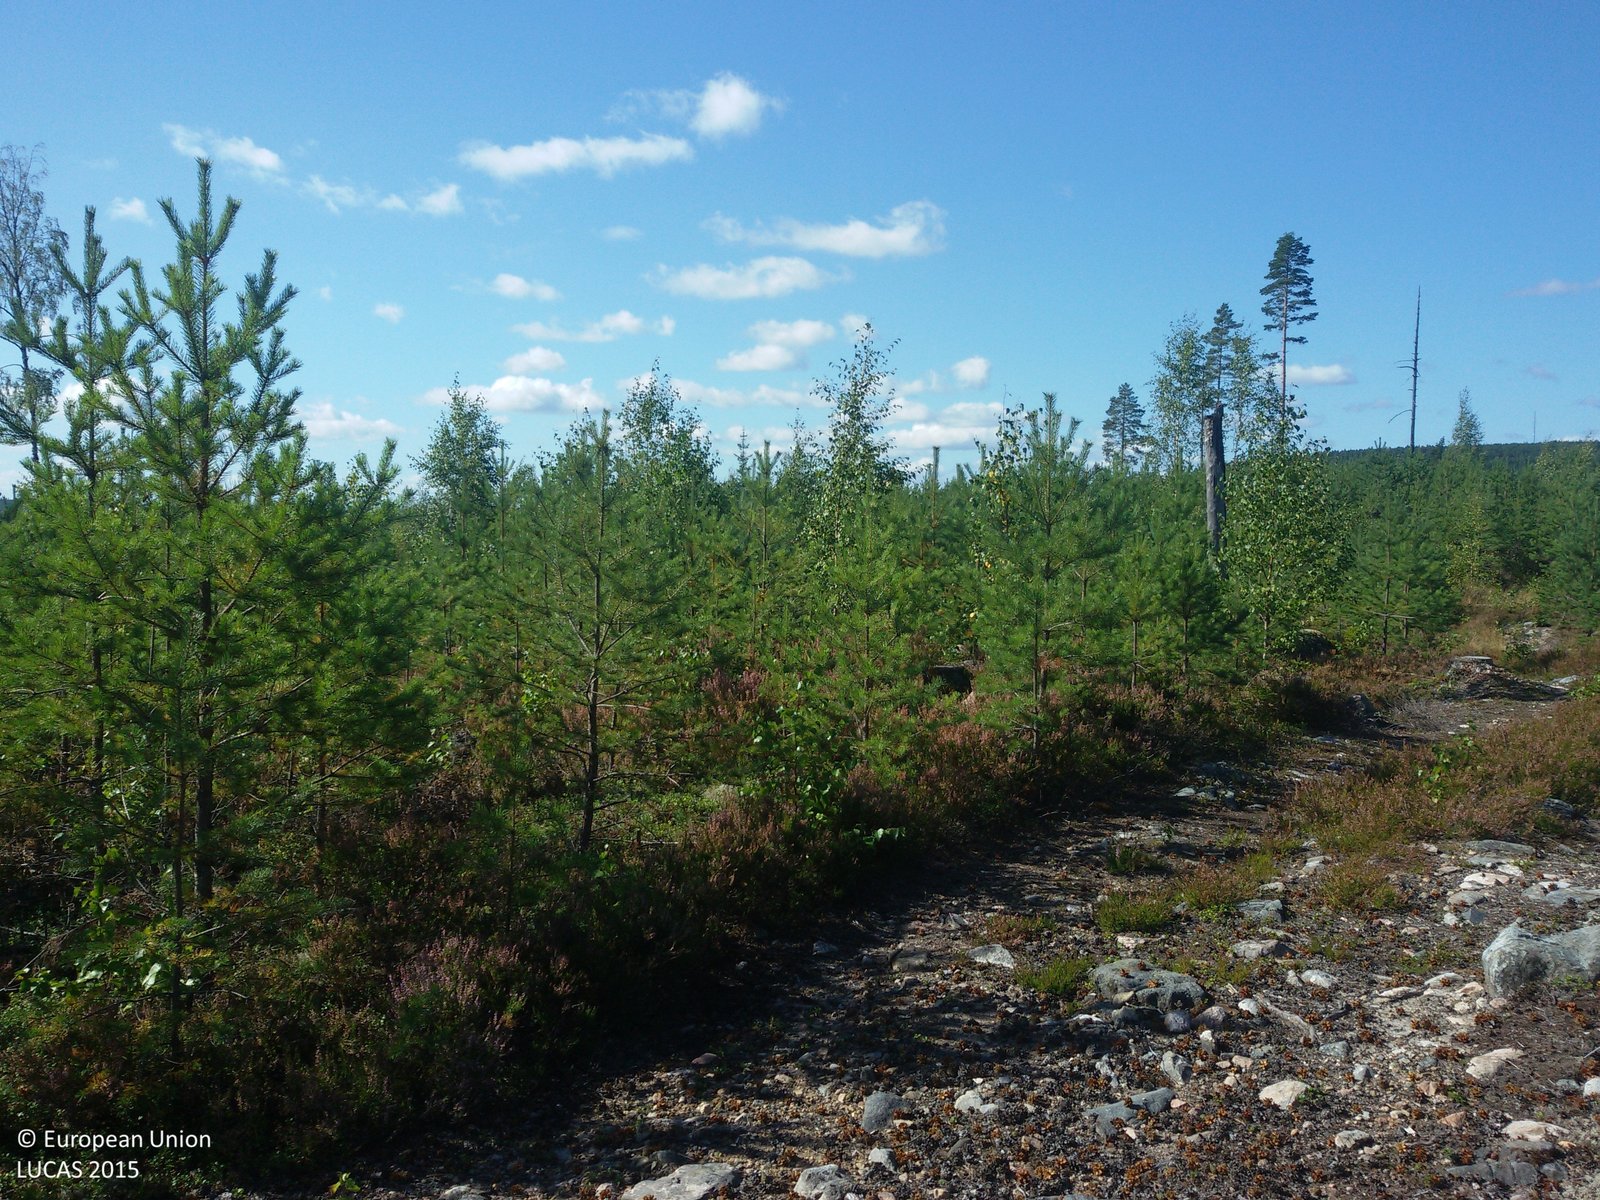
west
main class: Woodland
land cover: Pine dominated coniferous woodland
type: boreal forest
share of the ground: 50 - 75 %
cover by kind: coniferous forest trees 60 %, herbaceous plants 20 %, broadleaved forest trees 10 %, lichens and mosses 10 %
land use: Forestry
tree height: < 5 m
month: August
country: SE
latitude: 60.6608
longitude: 15.7139
